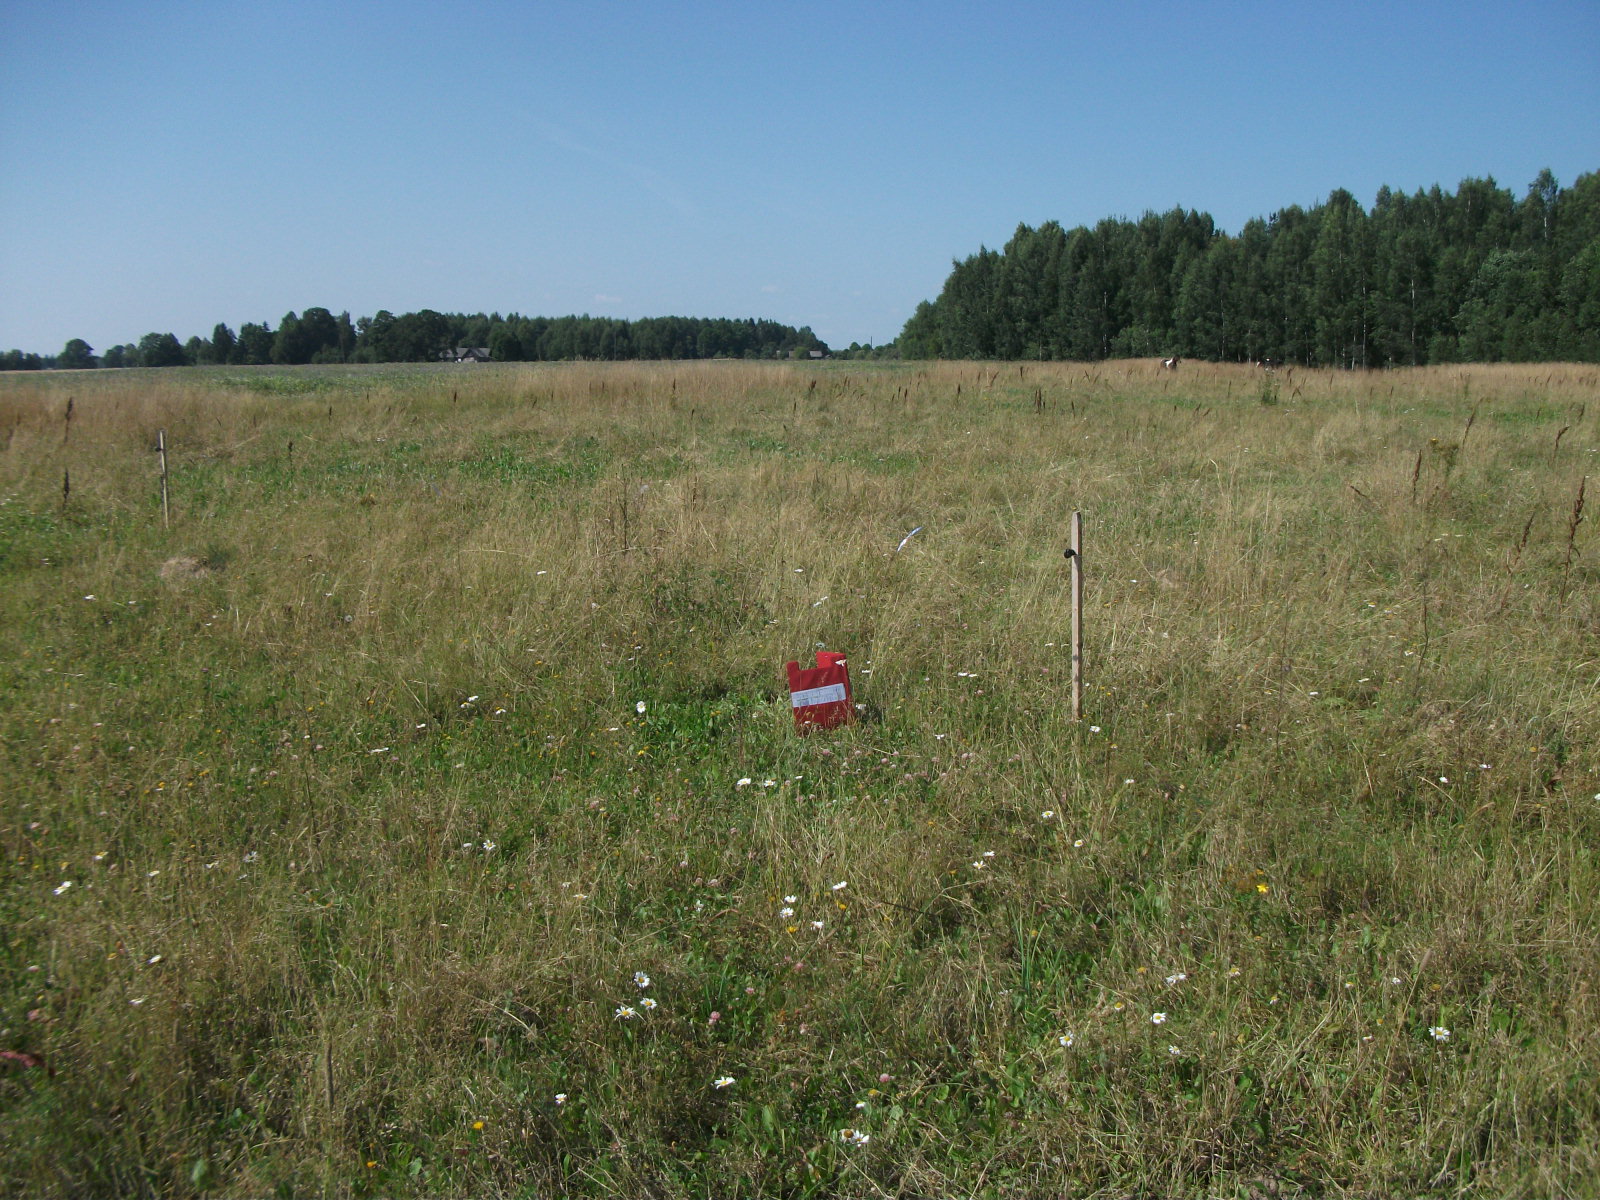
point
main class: Grassland
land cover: Grassland without tree/shrub cover
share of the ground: > 75 %
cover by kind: herbaceous plants 100 %
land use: Agriculture (excluding fallow land and kitchen gardens)
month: August
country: LV
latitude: 56.6534
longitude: 26.5075
